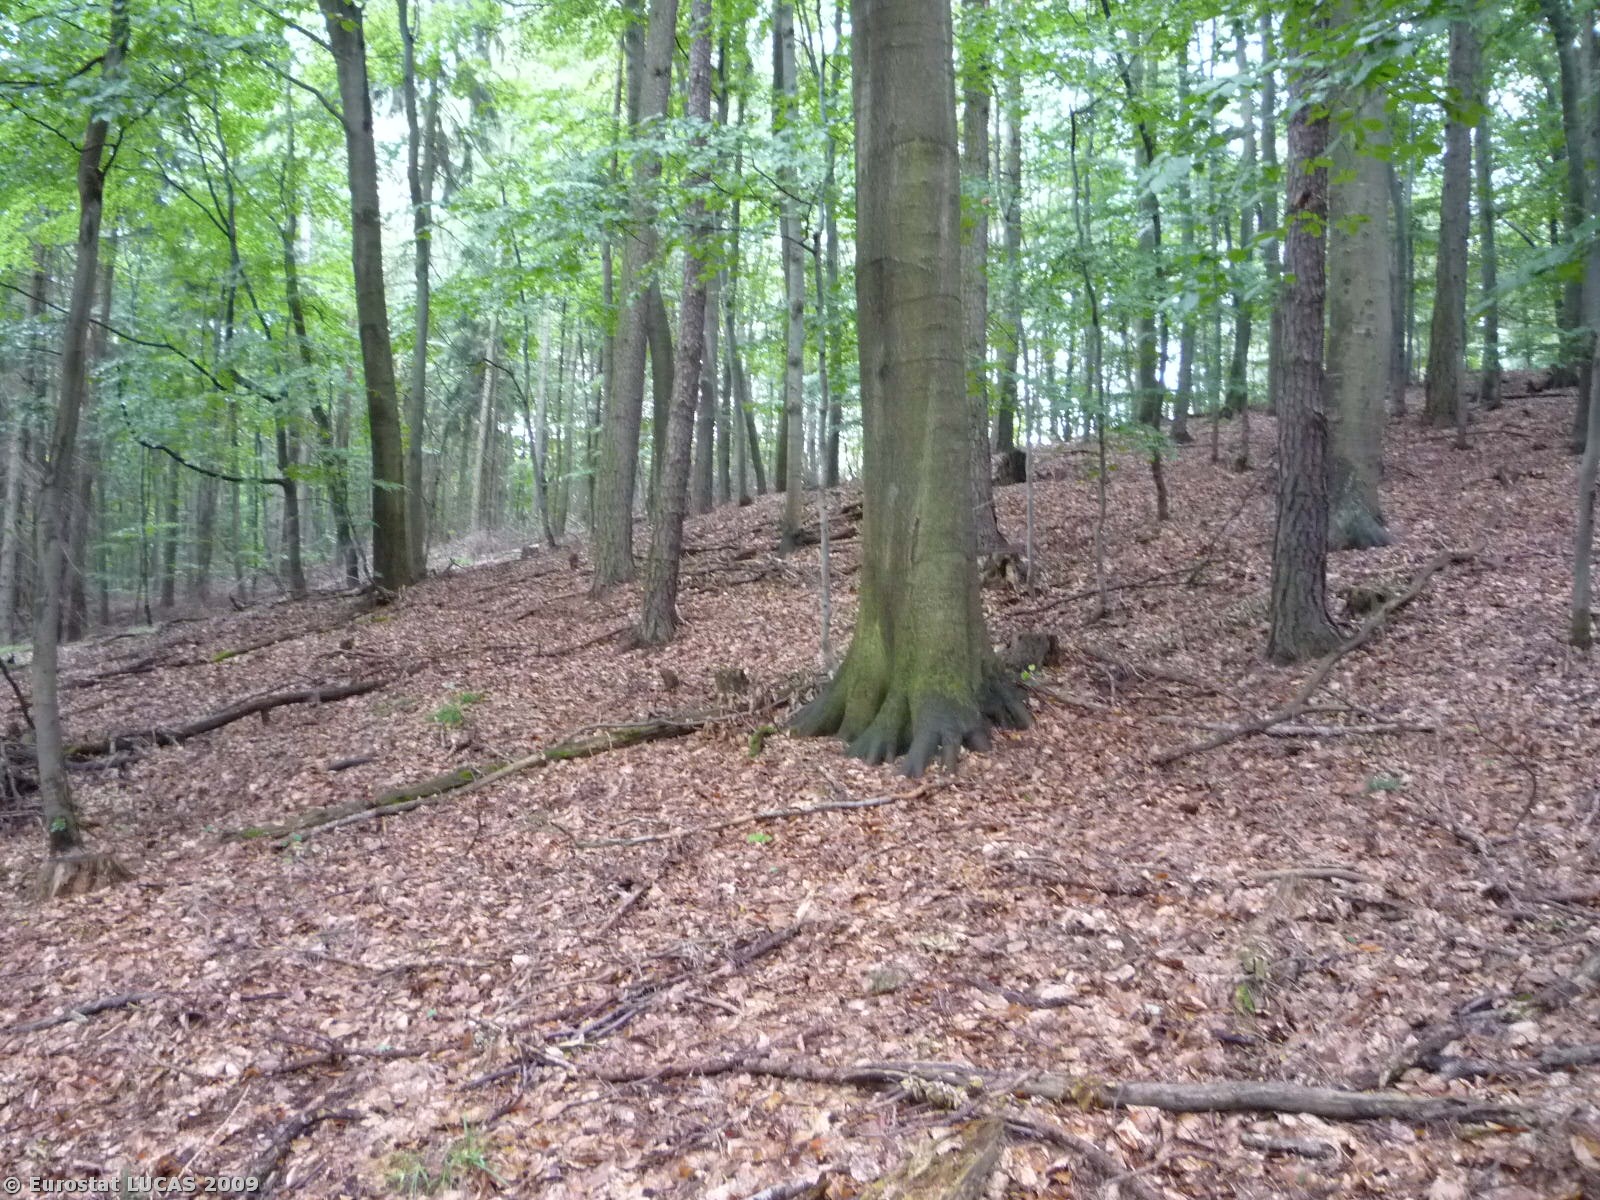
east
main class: Woodland
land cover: Mixed woodland
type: hemiboreal forest and nemoral coniferous forest and mixed broadleaved-coniferous forest
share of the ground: > 75 %
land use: Forestry
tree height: > 5 m
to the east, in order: Mixed woodland; Broadleaved woodland; Coniferous woodland; Broadleaved woodland; Ditches and canals; Tracks; Grass margins; Fences; Broadleaved woodland
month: June
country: CZ
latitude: 49.9172
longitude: 14.8909
